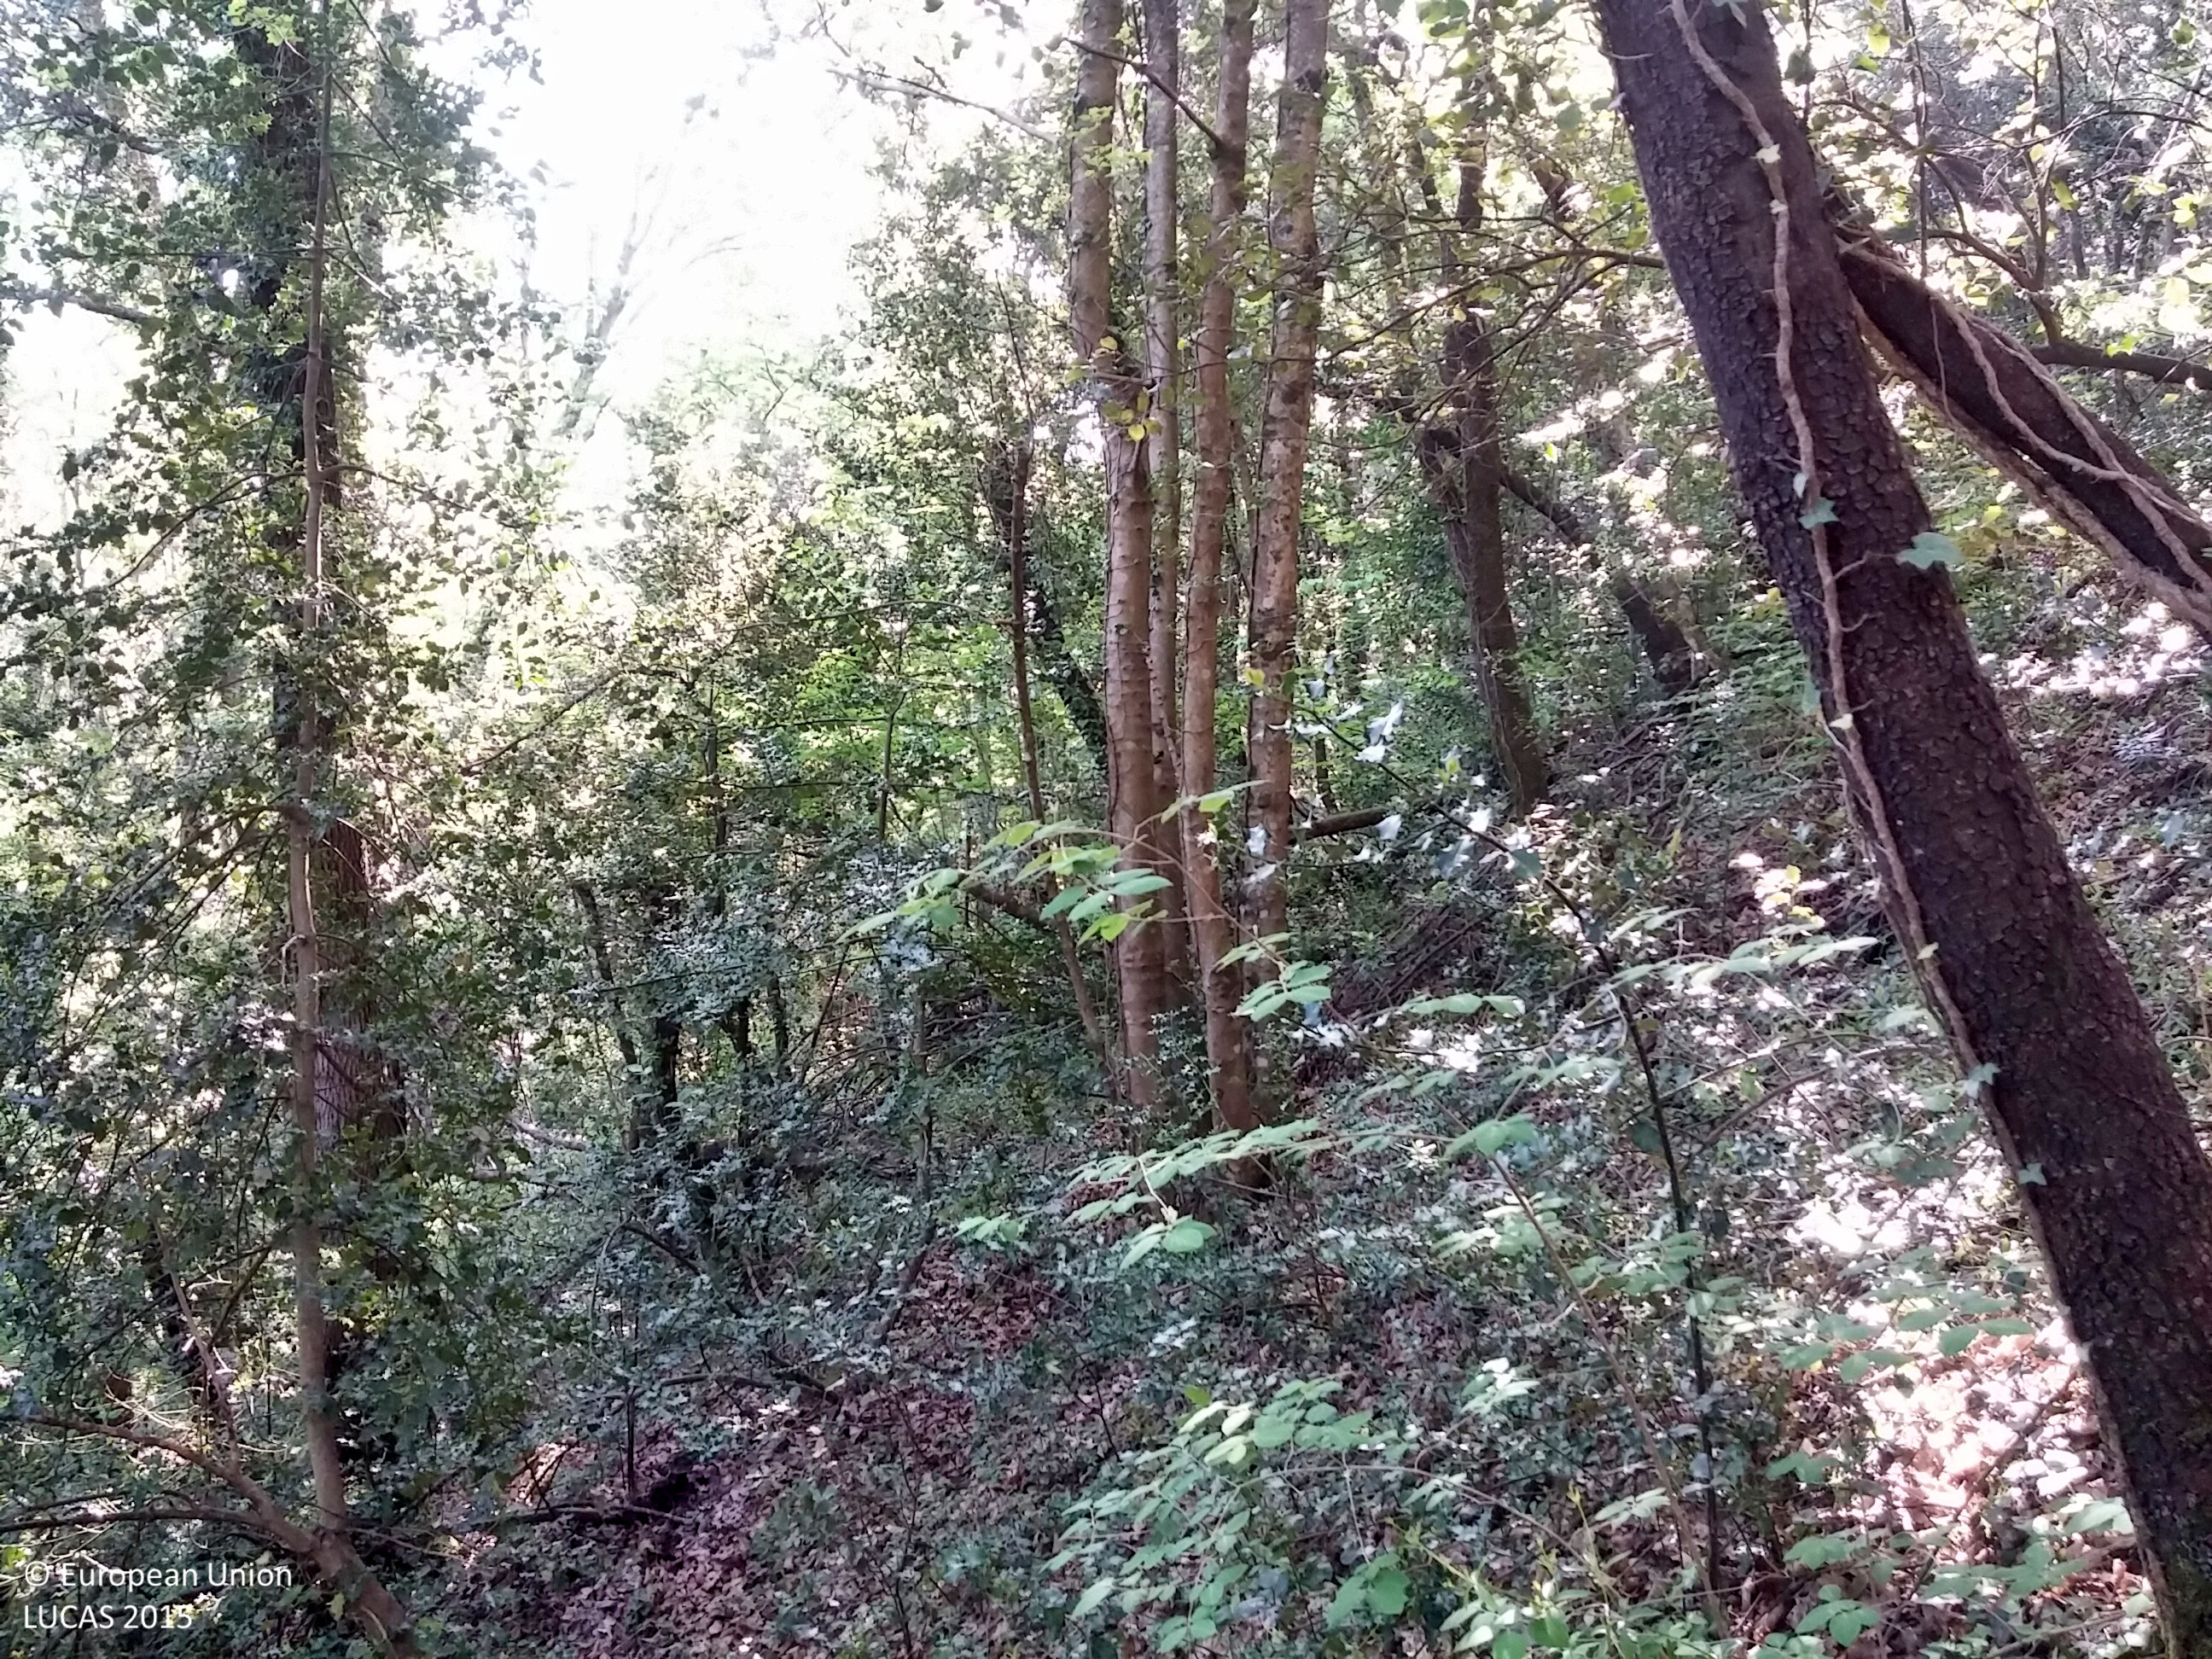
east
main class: Woodland
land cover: Broadleaved woodland
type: thermophilous deciduous forest
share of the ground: > 75 %
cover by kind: broadleaved forest trees 80 %, shrubs 20 %
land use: Forestry
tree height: > 5 m
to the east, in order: Broadleaved woodland
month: May
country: ES
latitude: 42.1957
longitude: 2.5178
